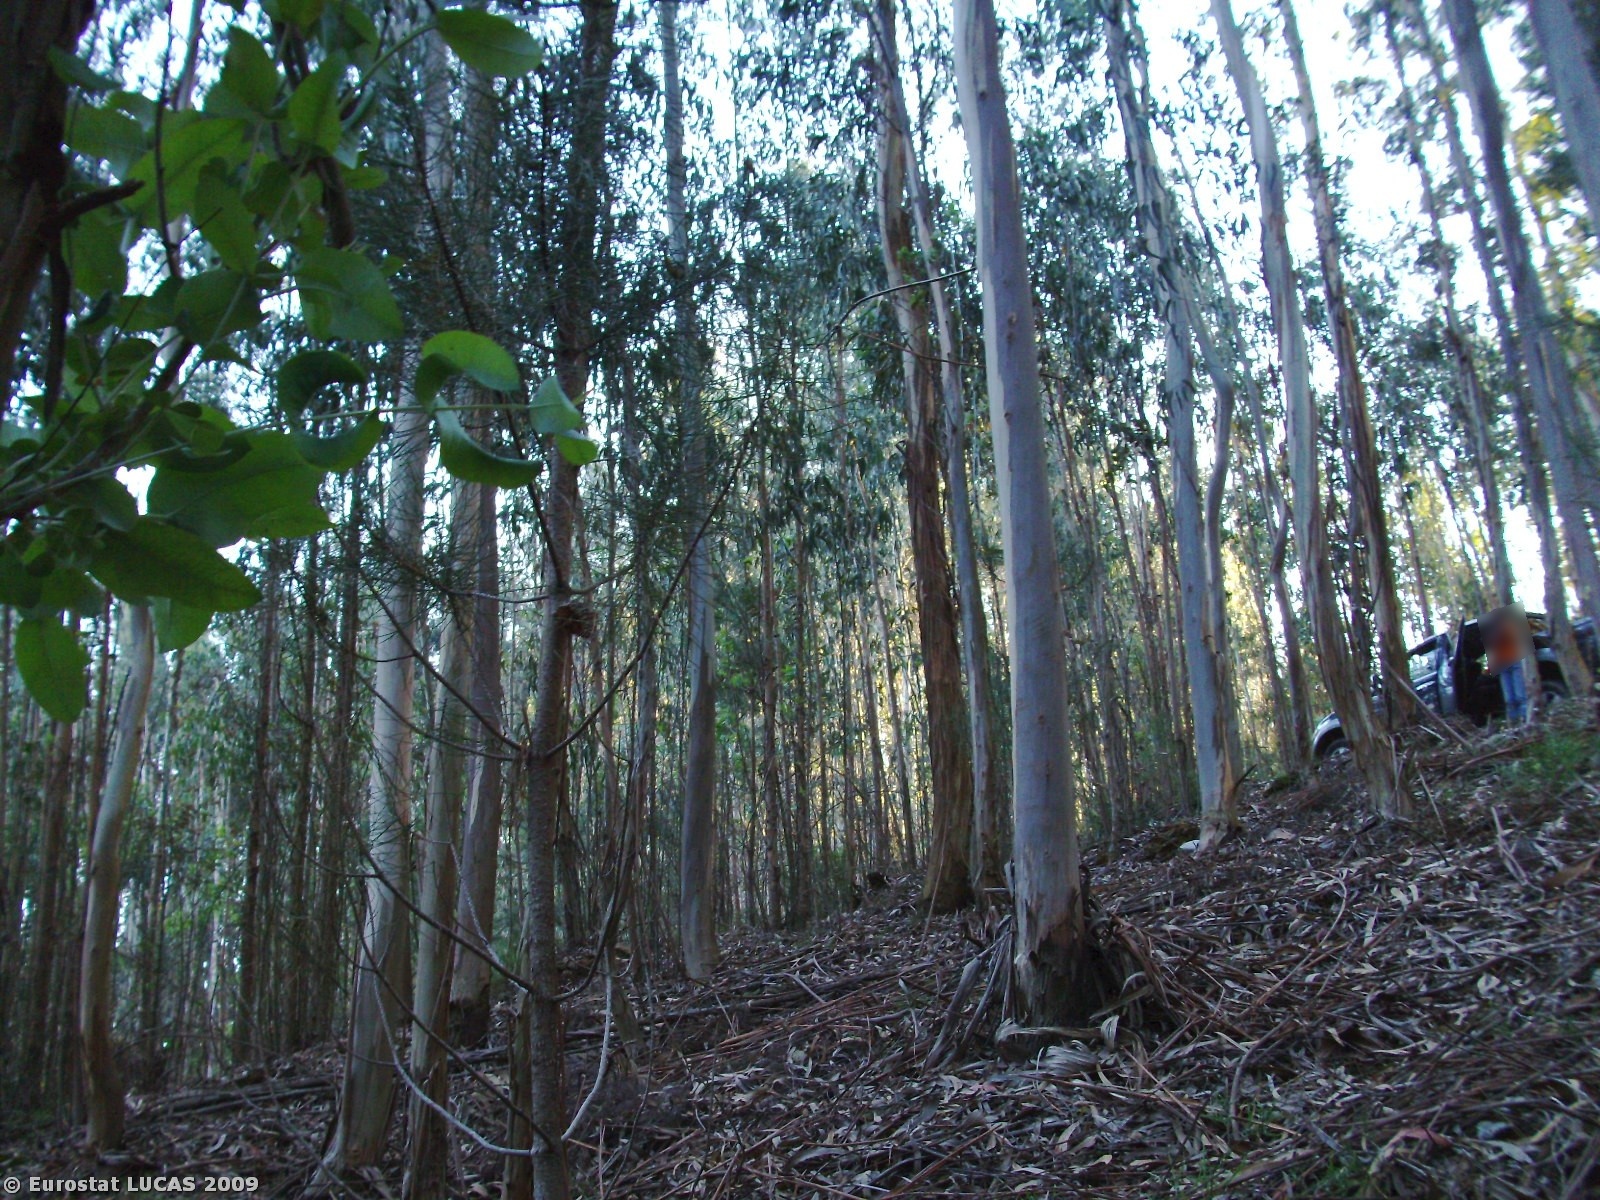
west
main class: Woodland
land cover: Broadleaved woodland
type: plantations and self-sown exotic forest
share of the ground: > 75 %
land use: Forestry
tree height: > 5 m
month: May
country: PT
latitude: 40.7757
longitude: -8.4471
